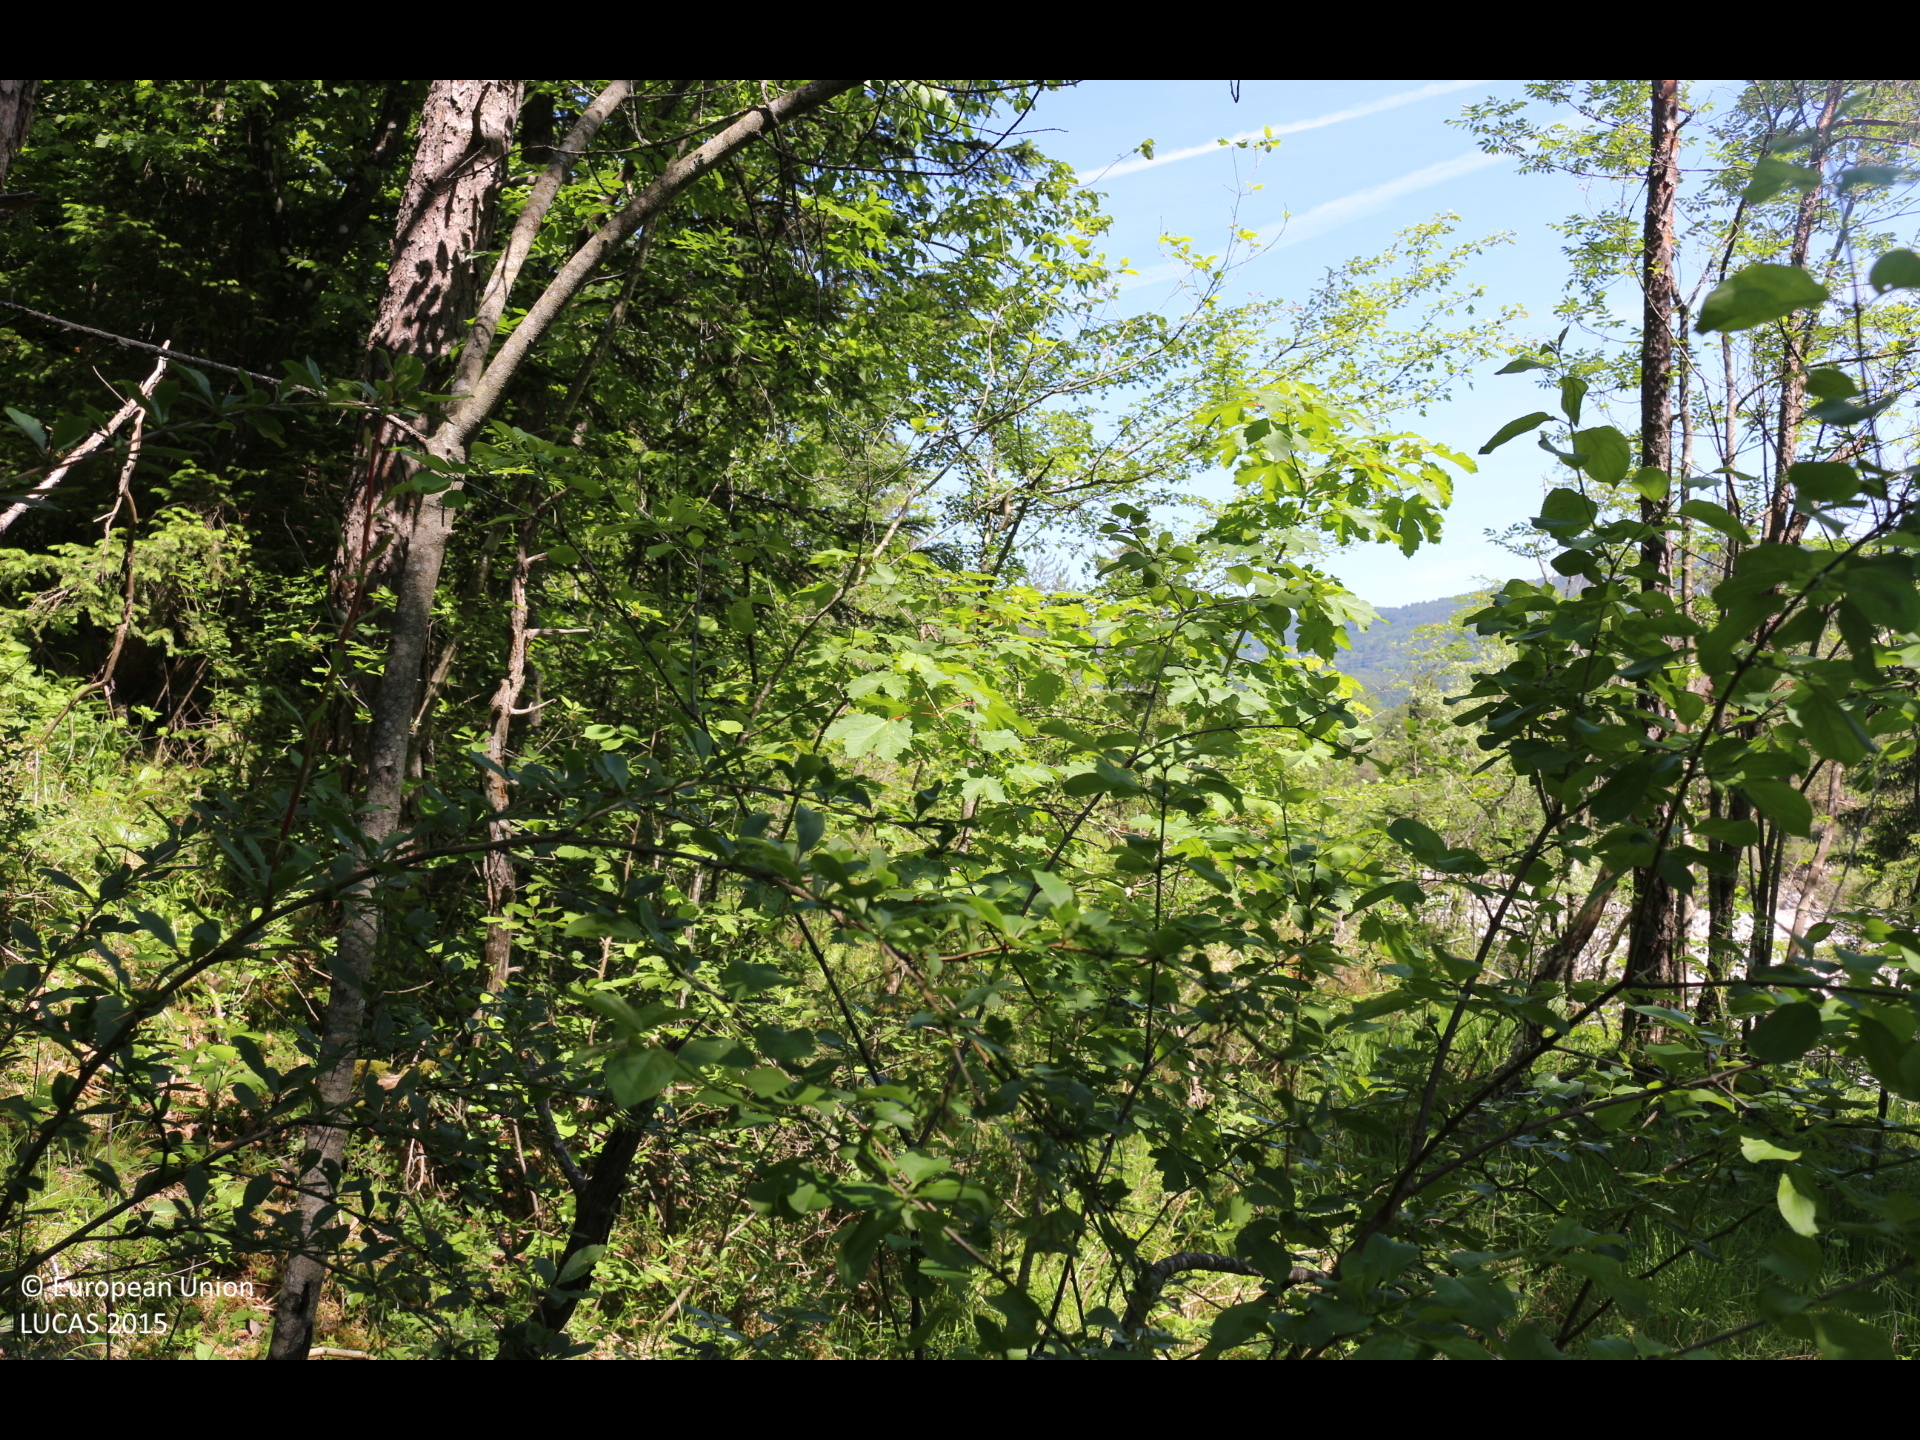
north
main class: Woodland
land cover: Pine dominated mixed woodland
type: alpine coniferous forest
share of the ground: > 75 %
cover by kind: coniferous forest trees 60 %, broadleaved forest trees 35 %, shrubs 5 %
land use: Forestry
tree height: > 5 m
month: May
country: AT
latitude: 46.5250
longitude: 14.1036
